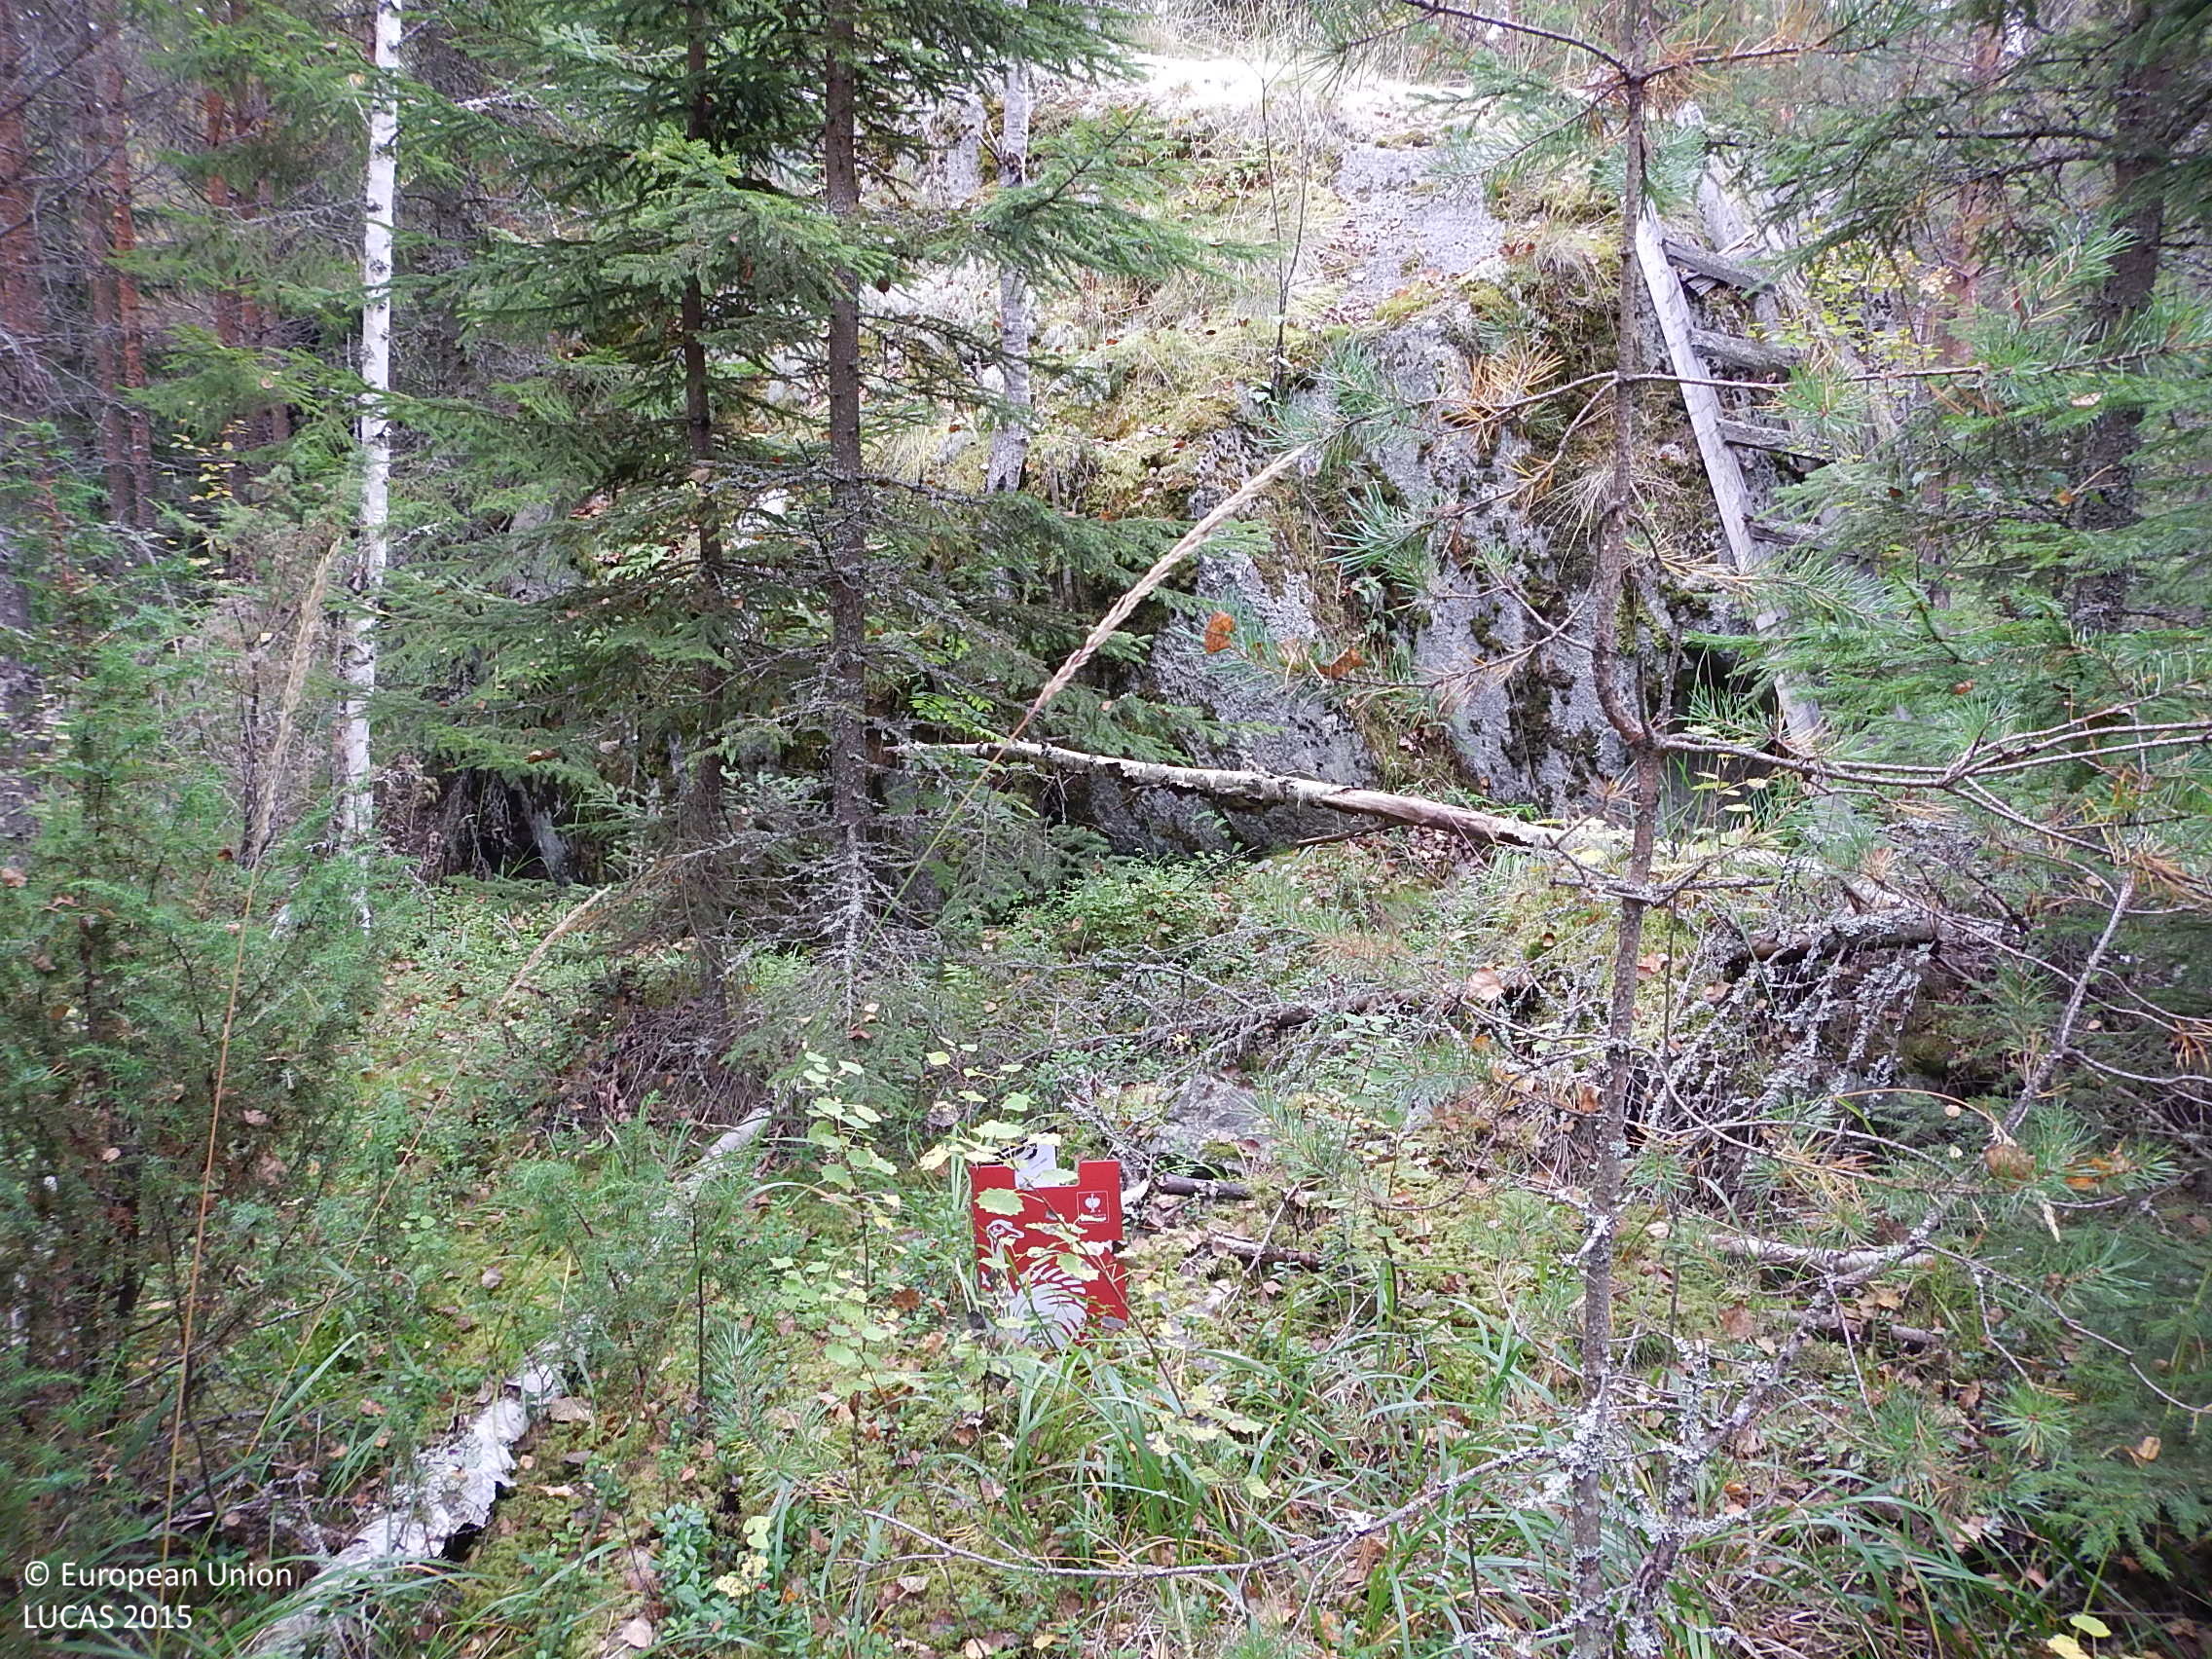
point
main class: Woodland
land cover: Other coniferous woodland
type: boreal forest
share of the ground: > 75 %
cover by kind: coniferous forest trees 60 %, broadleaved forest trees 15 %, shrubs 15 %, herbaceous plants 5 %, lichens and mosses 5 %
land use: Forestry
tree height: > 5 m
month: September
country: FI
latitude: 61.5426
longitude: 22.0404
